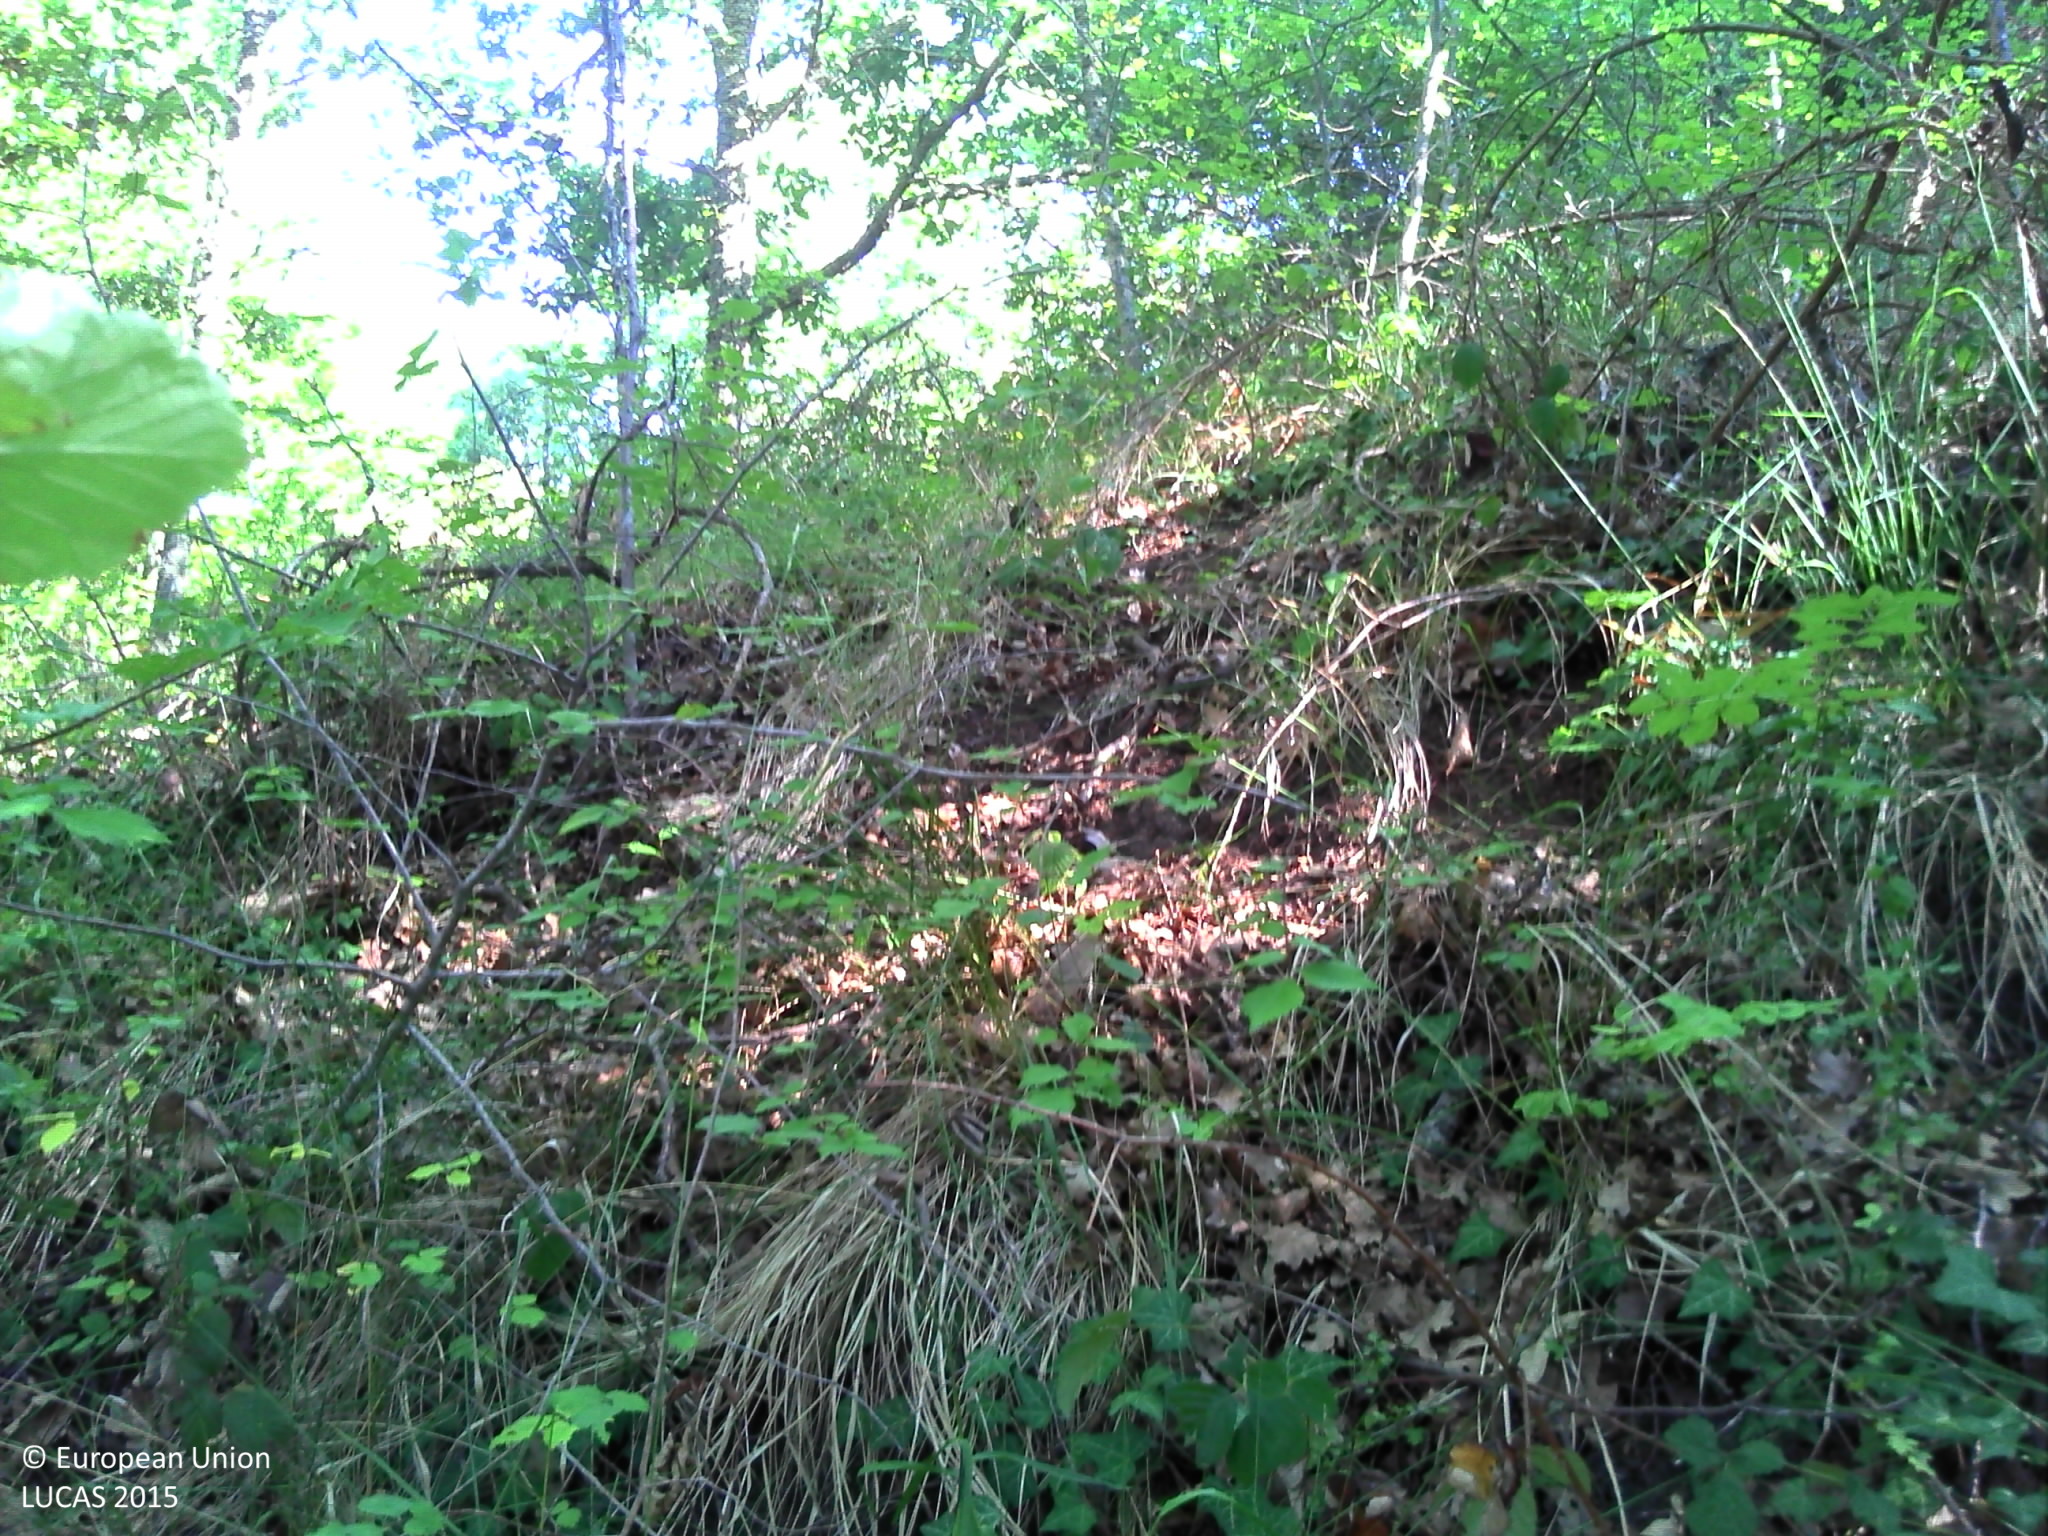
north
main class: Woodland
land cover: Broadleaved woodland
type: acidophilous oak and oak-birch forest
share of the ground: 50 - 75 %
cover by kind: broadleaved forest trees 60 %, herbaceous plants 30 %, unconsolidated bare surface 10 %
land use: Forestry
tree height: > 5 m
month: August
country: FR
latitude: 45.6017
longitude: 3.0642
